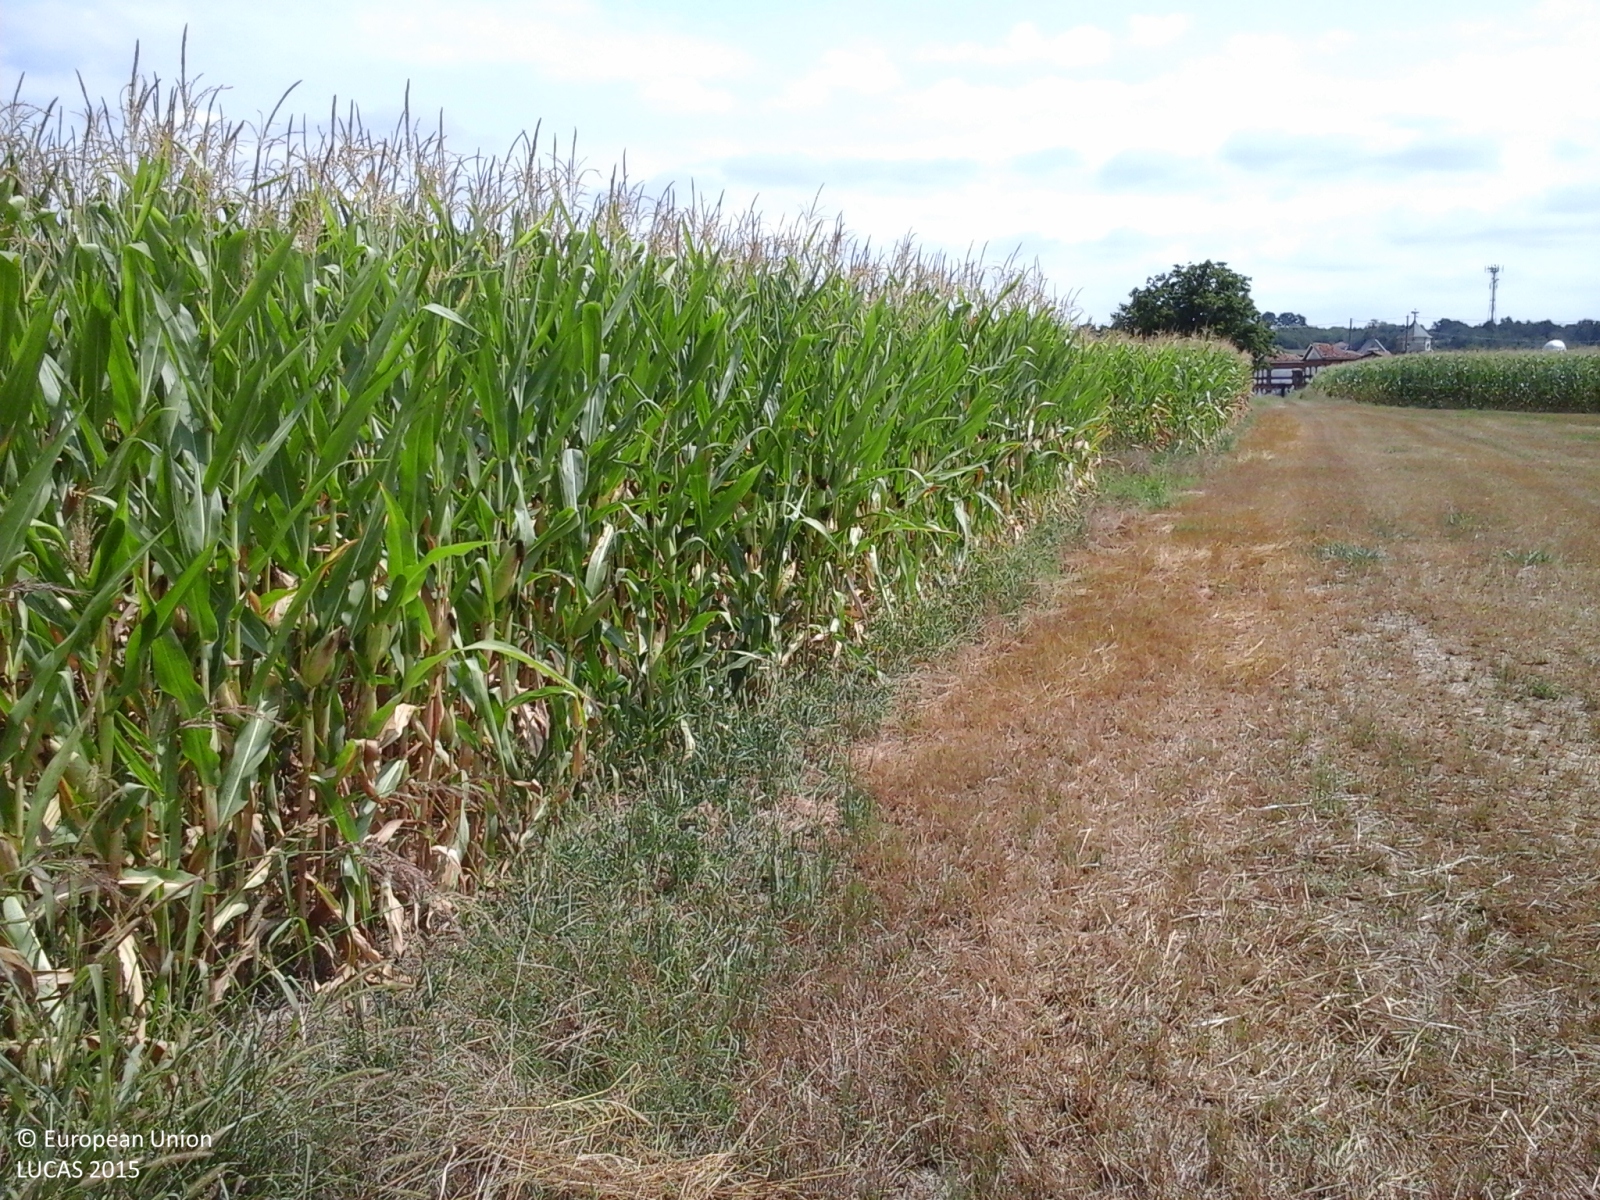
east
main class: Cropland
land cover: Maize
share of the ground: > 75 %
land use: Agriculture (excluding fallow land and kitchen gardens)
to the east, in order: Maize; Grassland without tree/shrub cover; Maize; Grassland without tree/shrub cover; Nuts trees; Grassland without tree/shrub cover; Common wheat; Electric lines; Grass margins; Paved roads, cycling and walking lanes; Maize; Electric lines; Maize; Common wheat
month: July
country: IT
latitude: 44.7966
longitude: 7.8173
